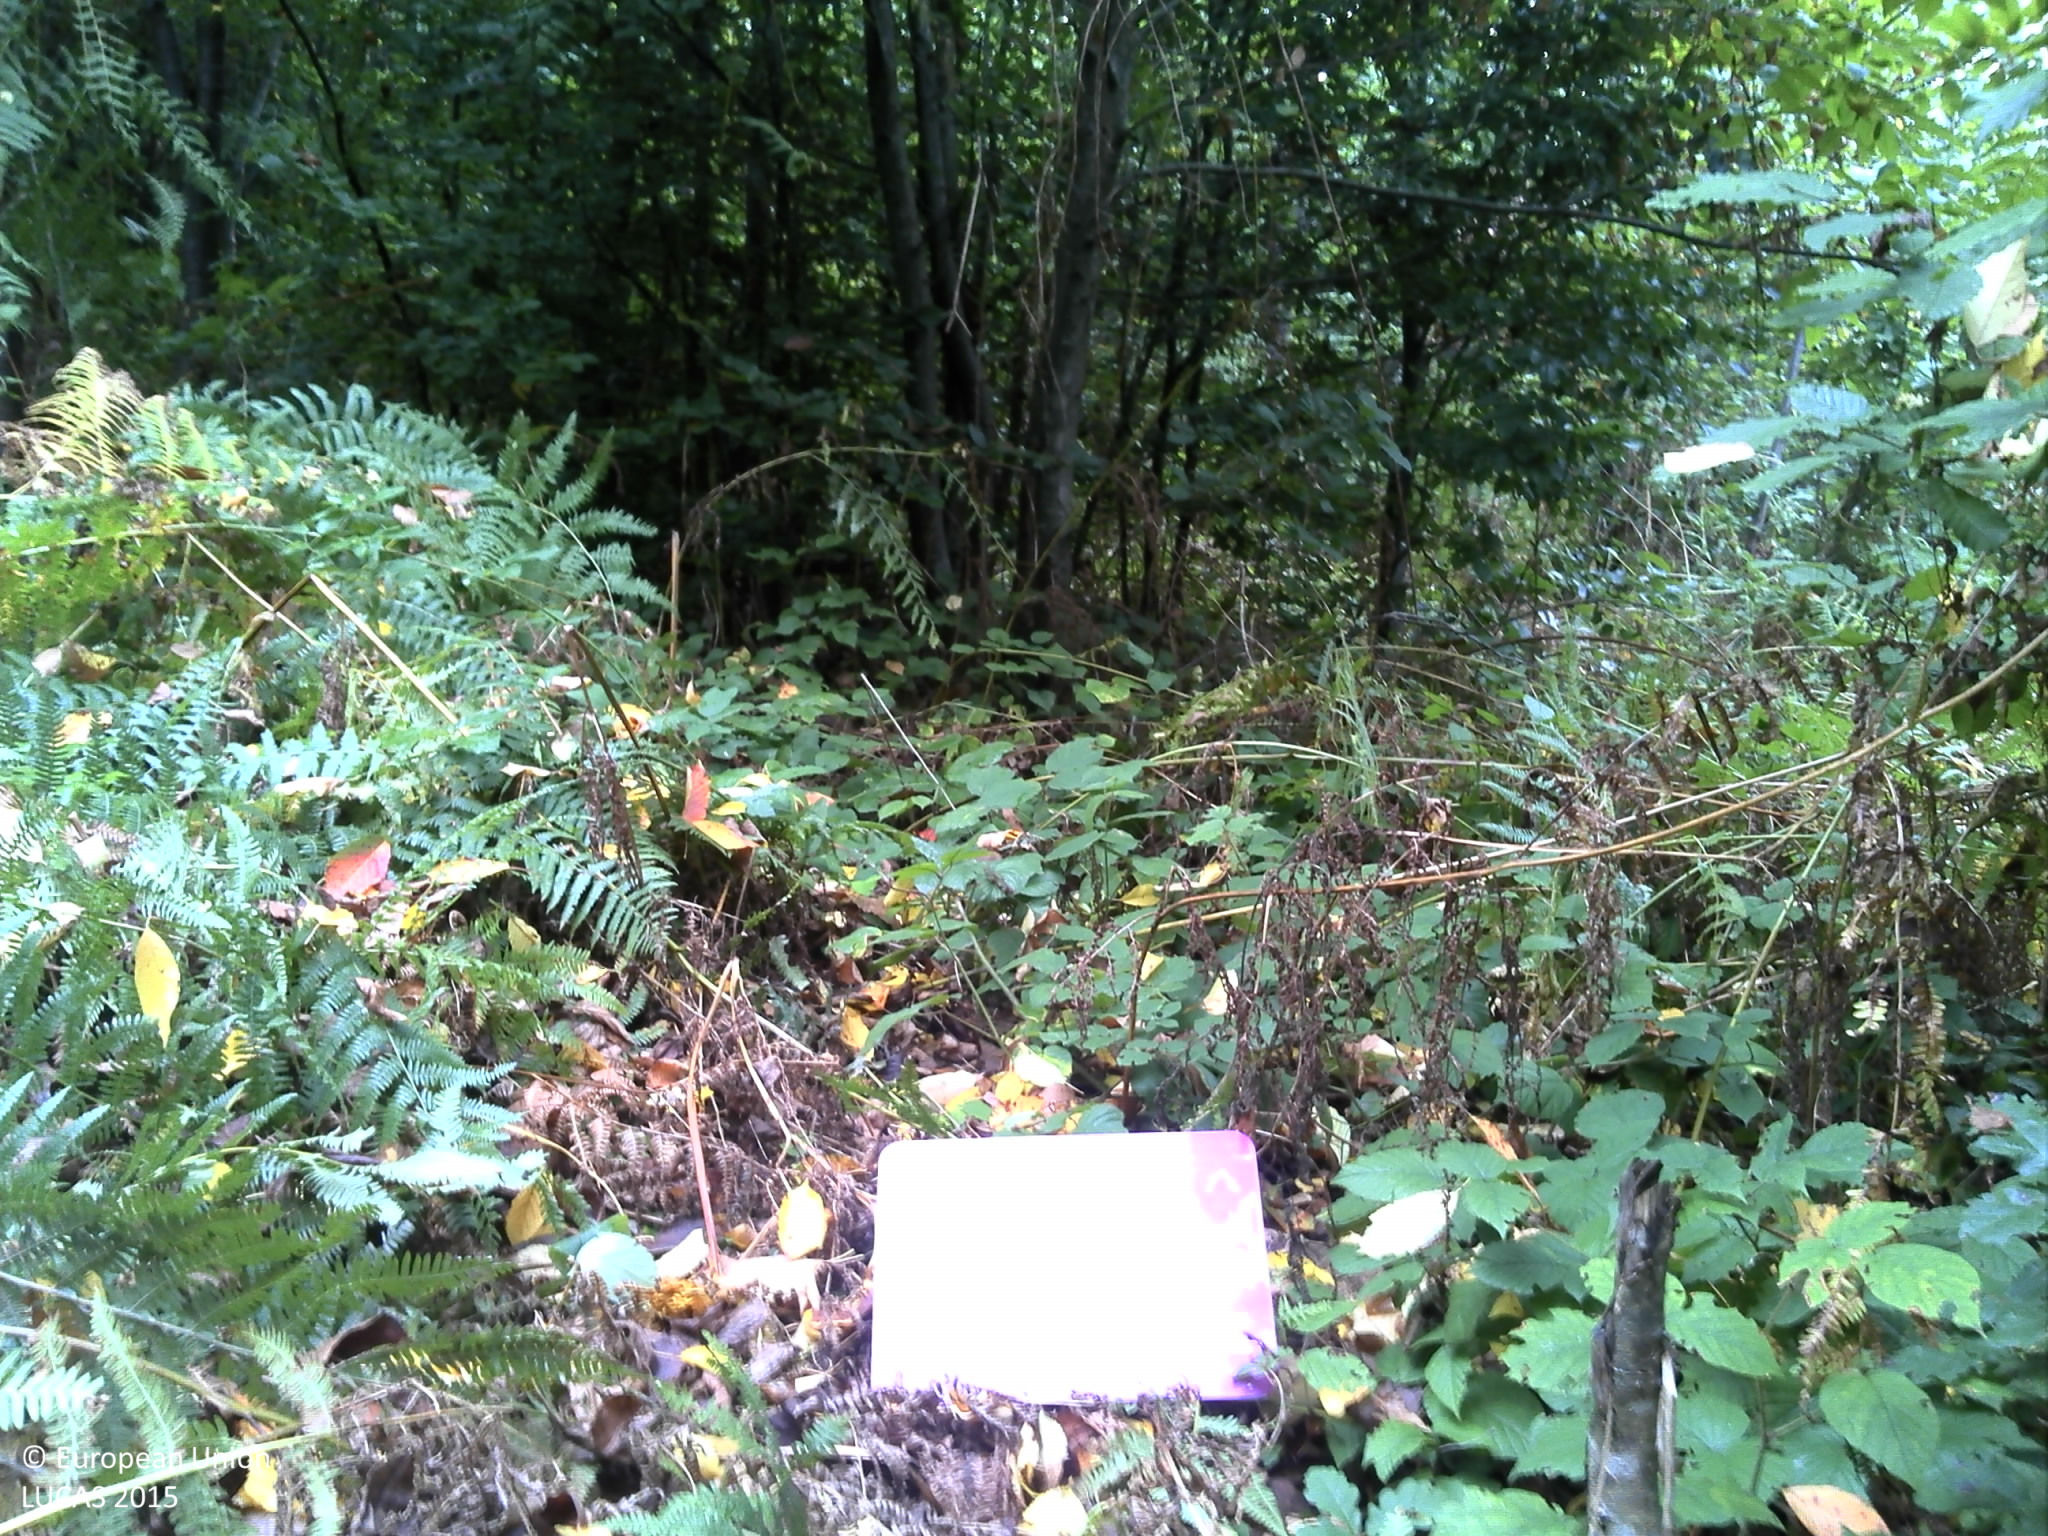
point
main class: Woodland
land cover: Broadleaved woodland
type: beech forest
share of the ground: > 75 %
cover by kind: broadleaved forest trees 100 %
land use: Forestry
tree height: > 5 m
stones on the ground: < 10 %
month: August
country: HR
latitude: 45.2450
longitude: 15.9714
